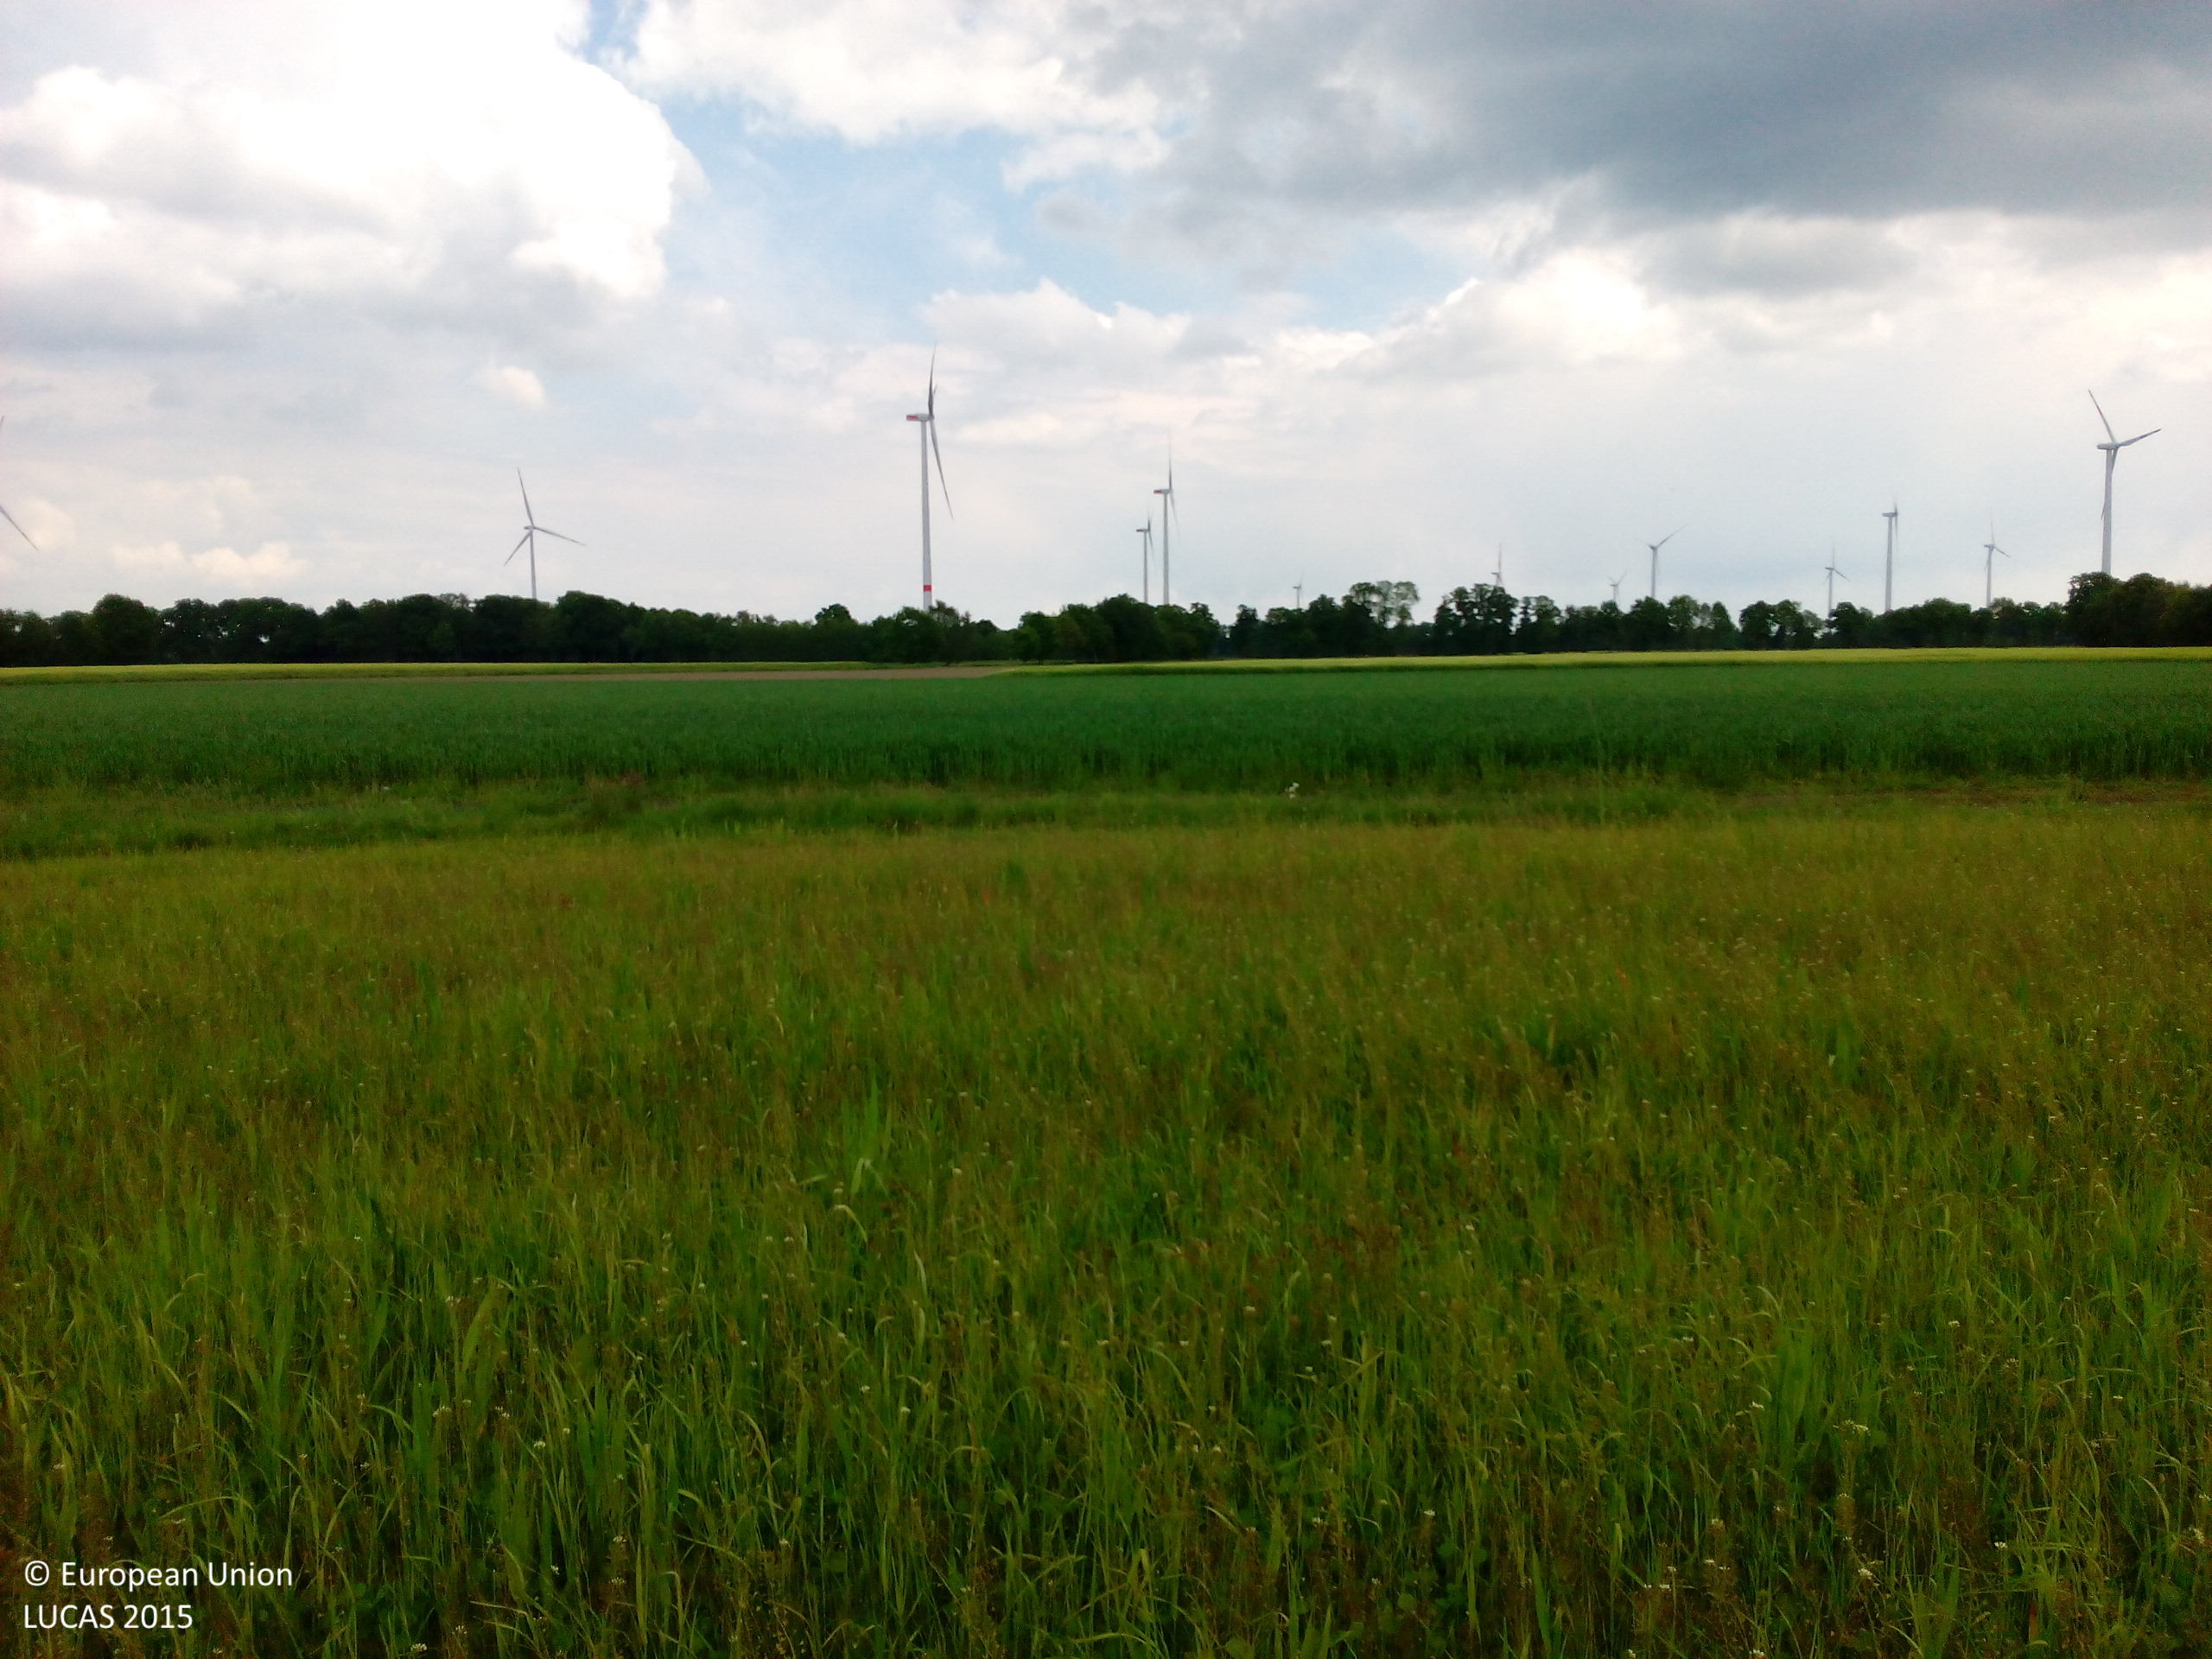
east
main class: Cropland
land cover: Mixed cereals for fodder
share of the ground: > 75 %
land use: Agriculture (excluding fallow land and kitchen gardens)
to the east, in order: Mixed cereals for fodder; Tracks; Common wheat; Maize; Grassland without tree/shrub cover; Ditches and canals; Grass margins; Tracks; Barley
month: May
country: DE
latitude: 52.1868
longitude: 7.3821
